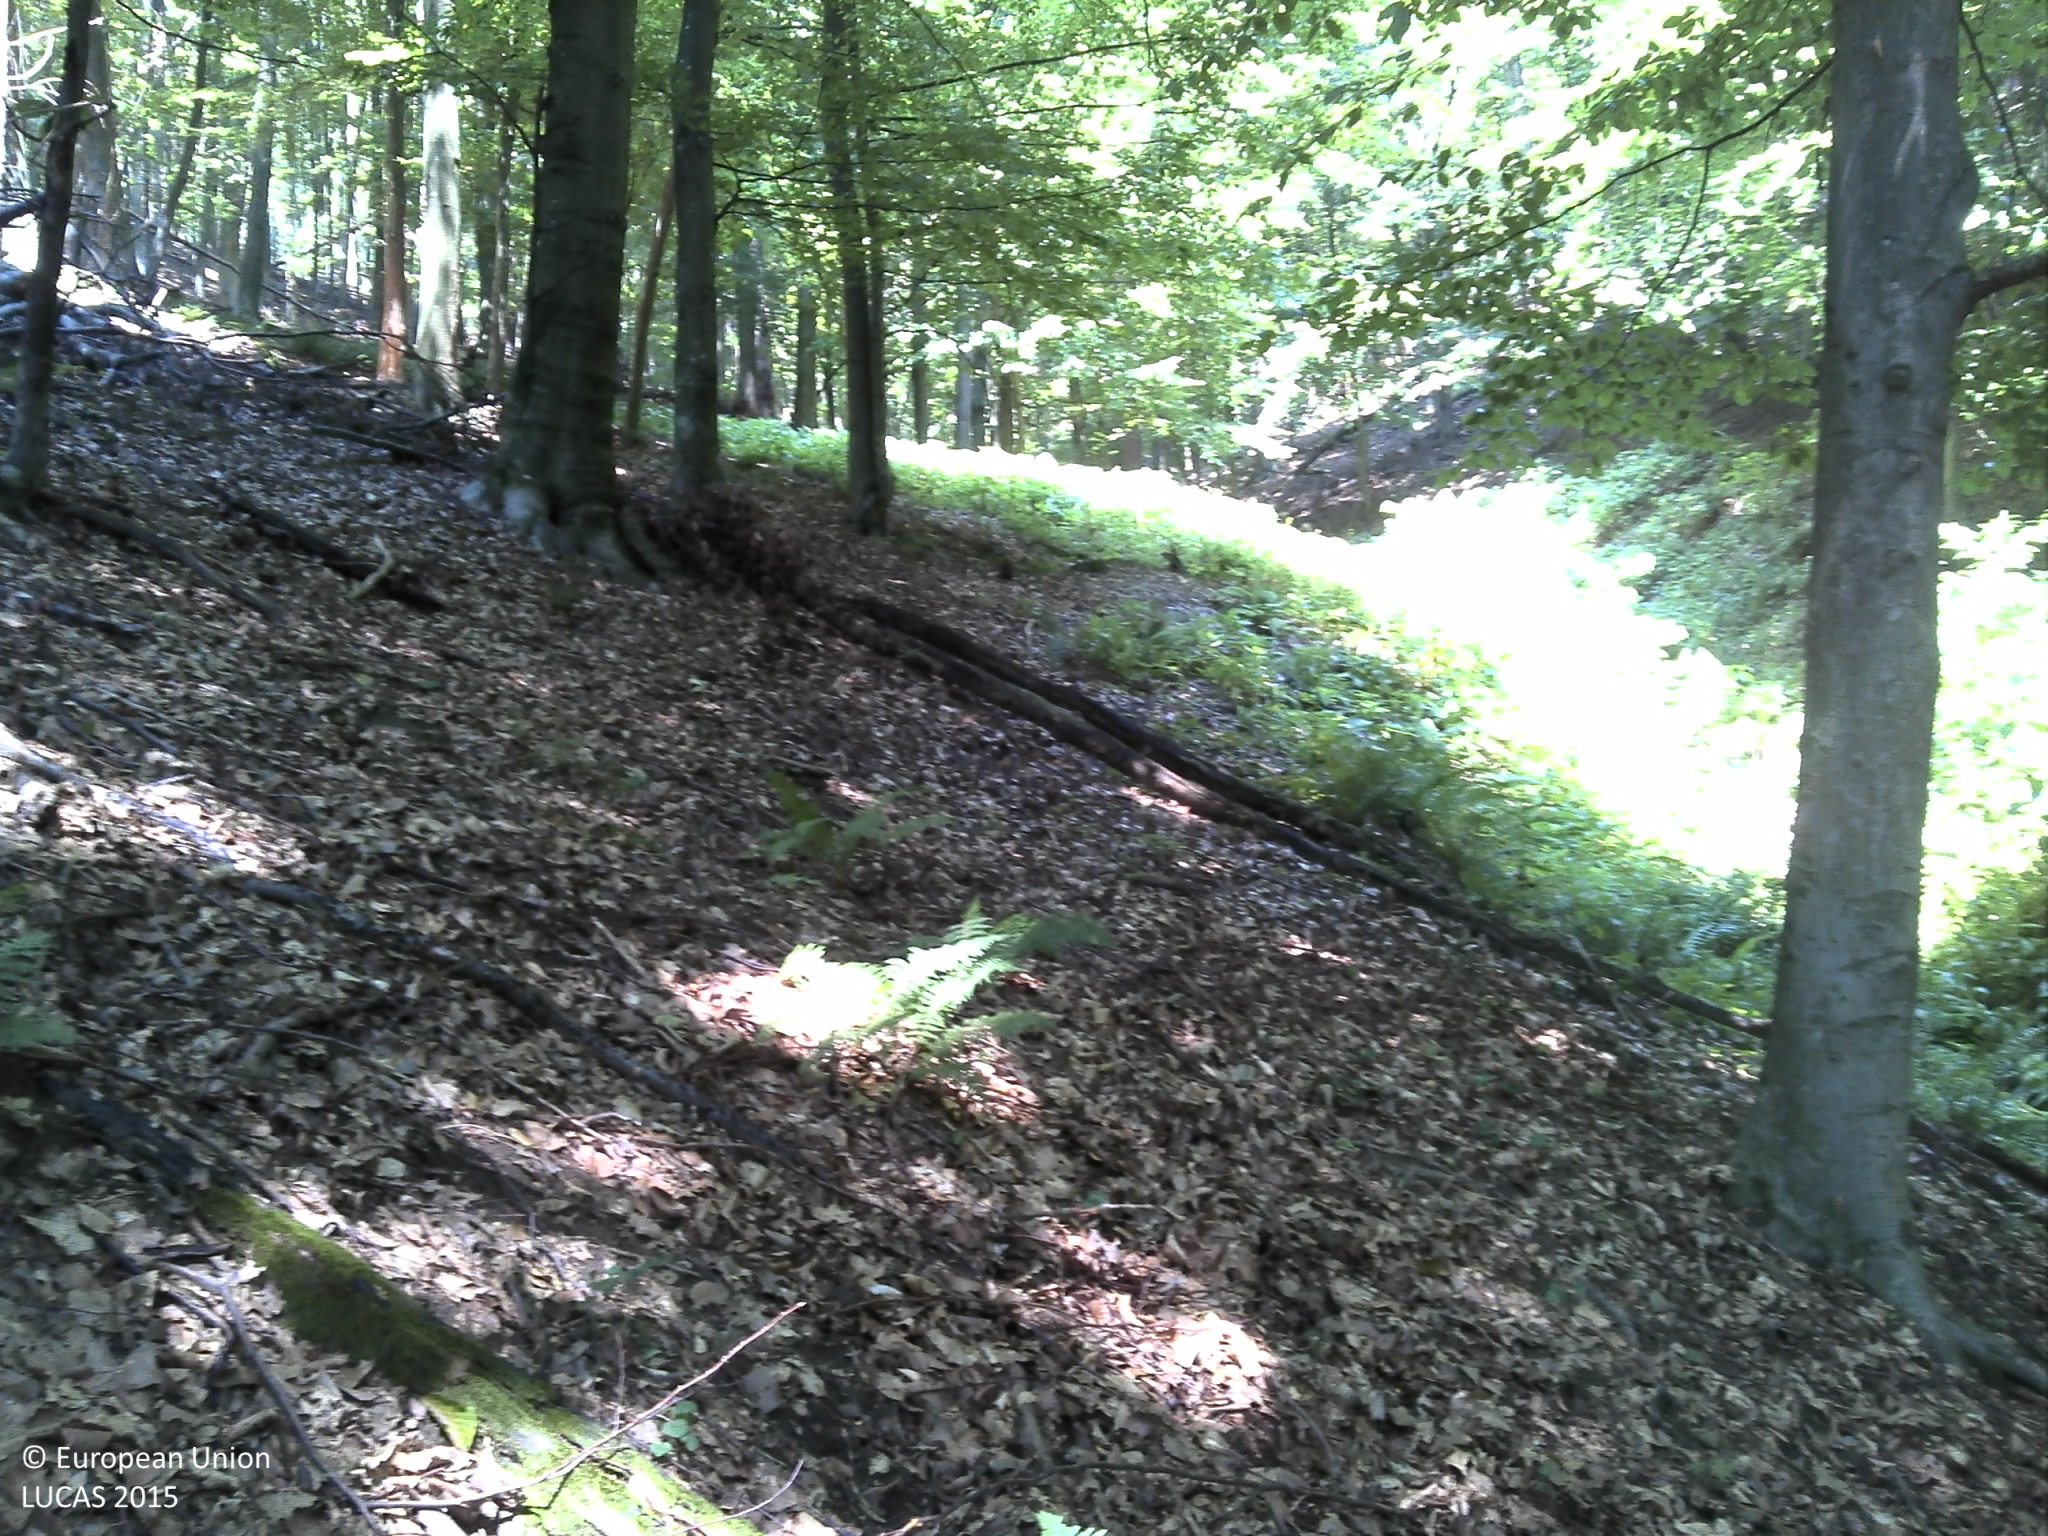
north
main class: Woodland
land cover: Broadleaved woodland
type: beech forest
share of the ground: > 75 %
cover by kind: broadleaved forest trees 80 %, lichens and mosses 20 %
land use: Forestry
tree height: > 5 m
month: July
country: HR
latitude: 45.6149
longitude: 16.7317
